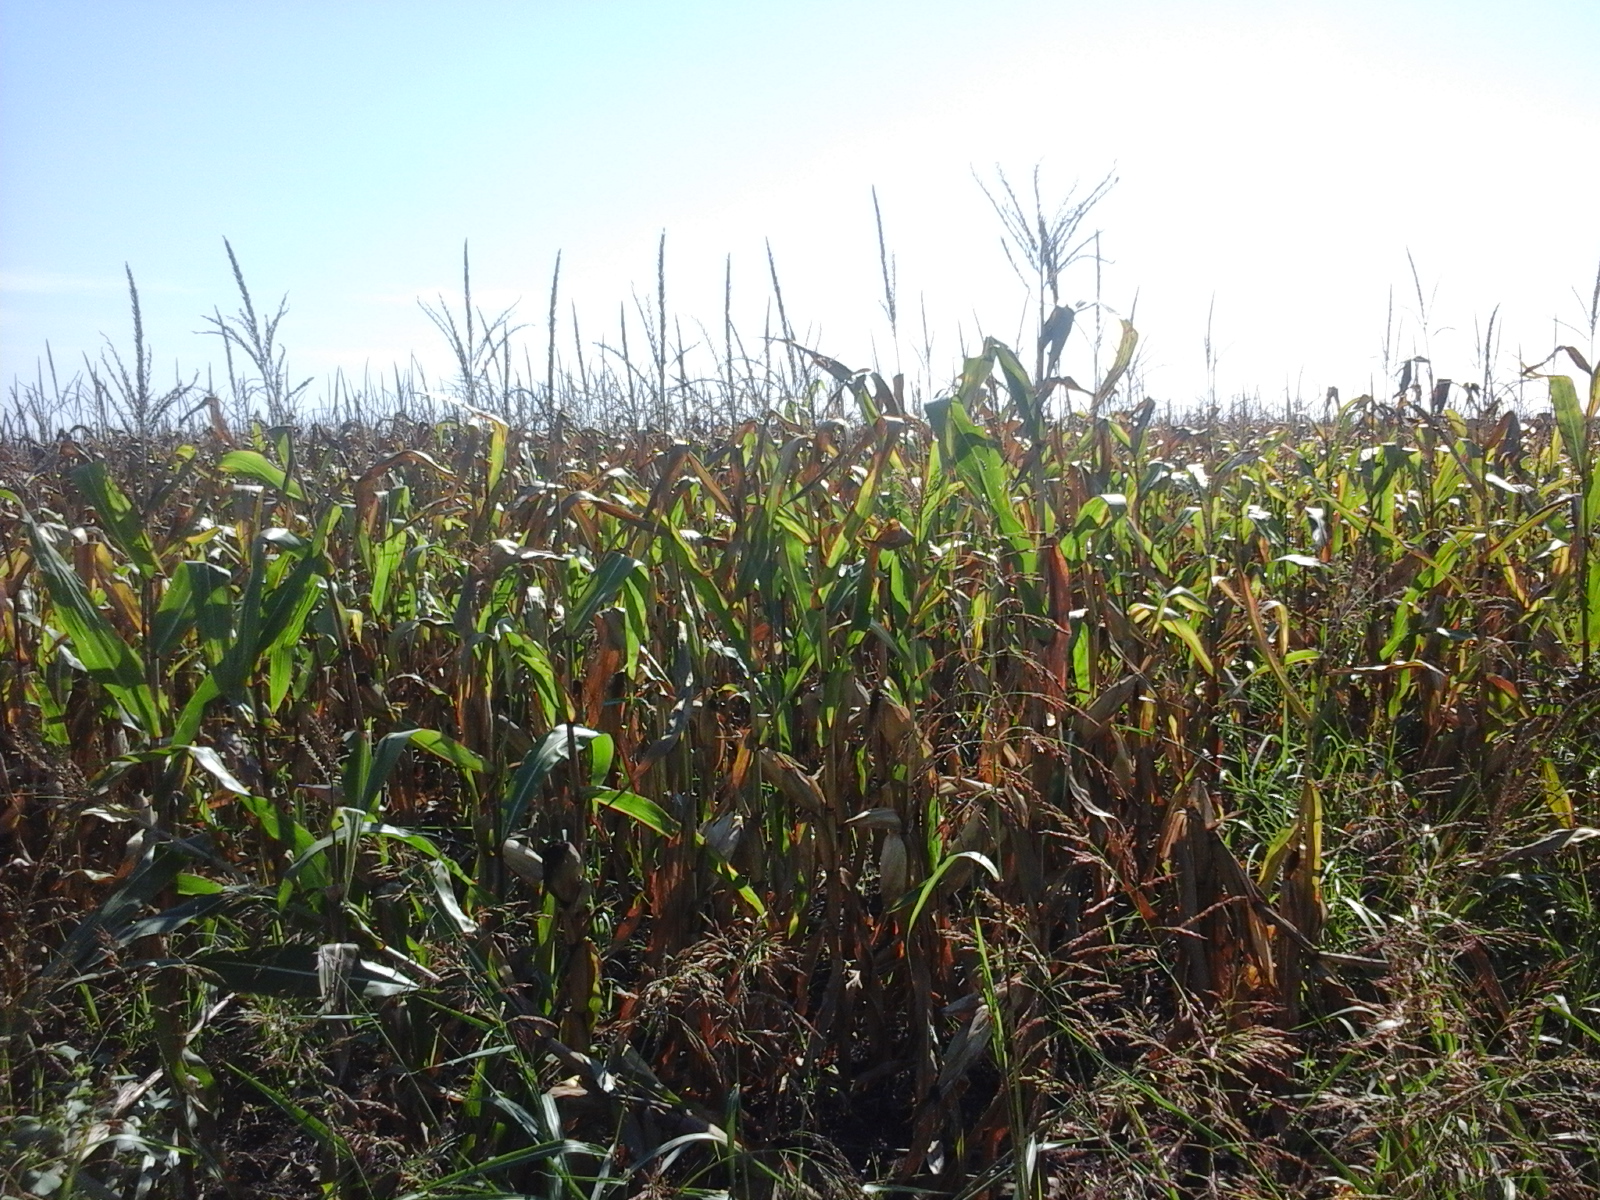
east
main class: Cropland
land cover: Sunflower
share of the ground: > 75 %
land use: Agriculture (excluding fallow land and kitchen gardens)
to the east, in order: Sunflower; Grass margins; Maize; Barley; Common wheat
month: August
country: RO
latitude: 46.0721
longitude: 21.0067
